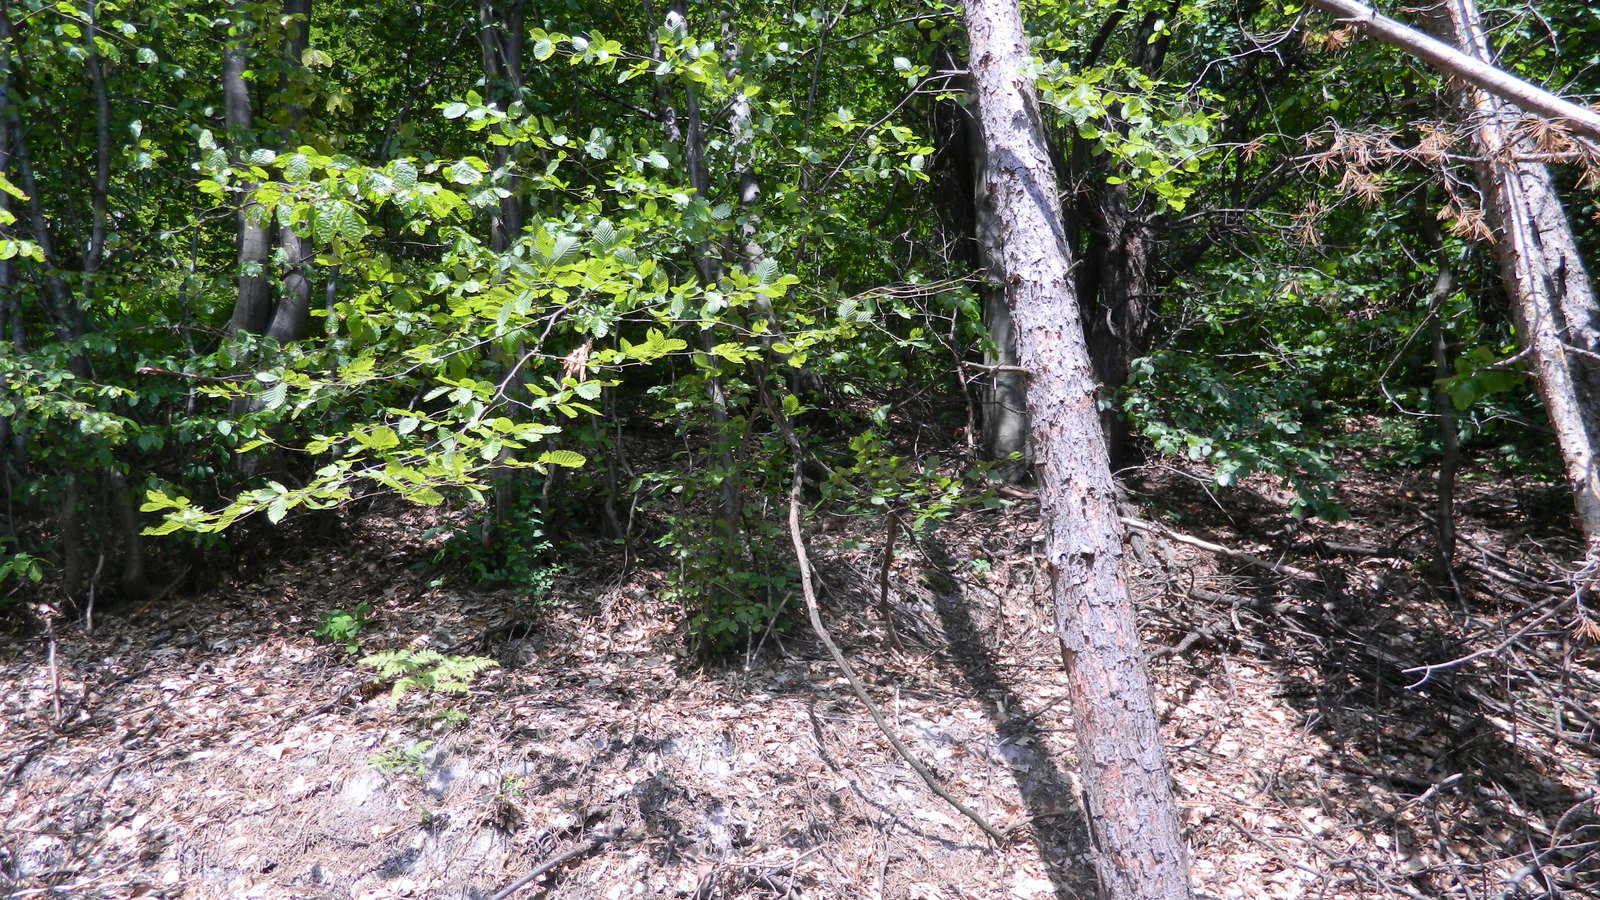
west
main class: Woodland
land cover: Pine dominated mixed woodland
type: hemiboreal forest and nemoral coniferous forest and mixed broadleaved-coniferous forest
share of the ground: > 75 %
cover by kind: coniferous forest trees 70 %, broadleaved forest trees 30 %
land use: Forestry
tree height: > 5 m
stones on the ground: < 10 %
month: July
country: BG
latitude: 41.8631
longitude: 24.9785
